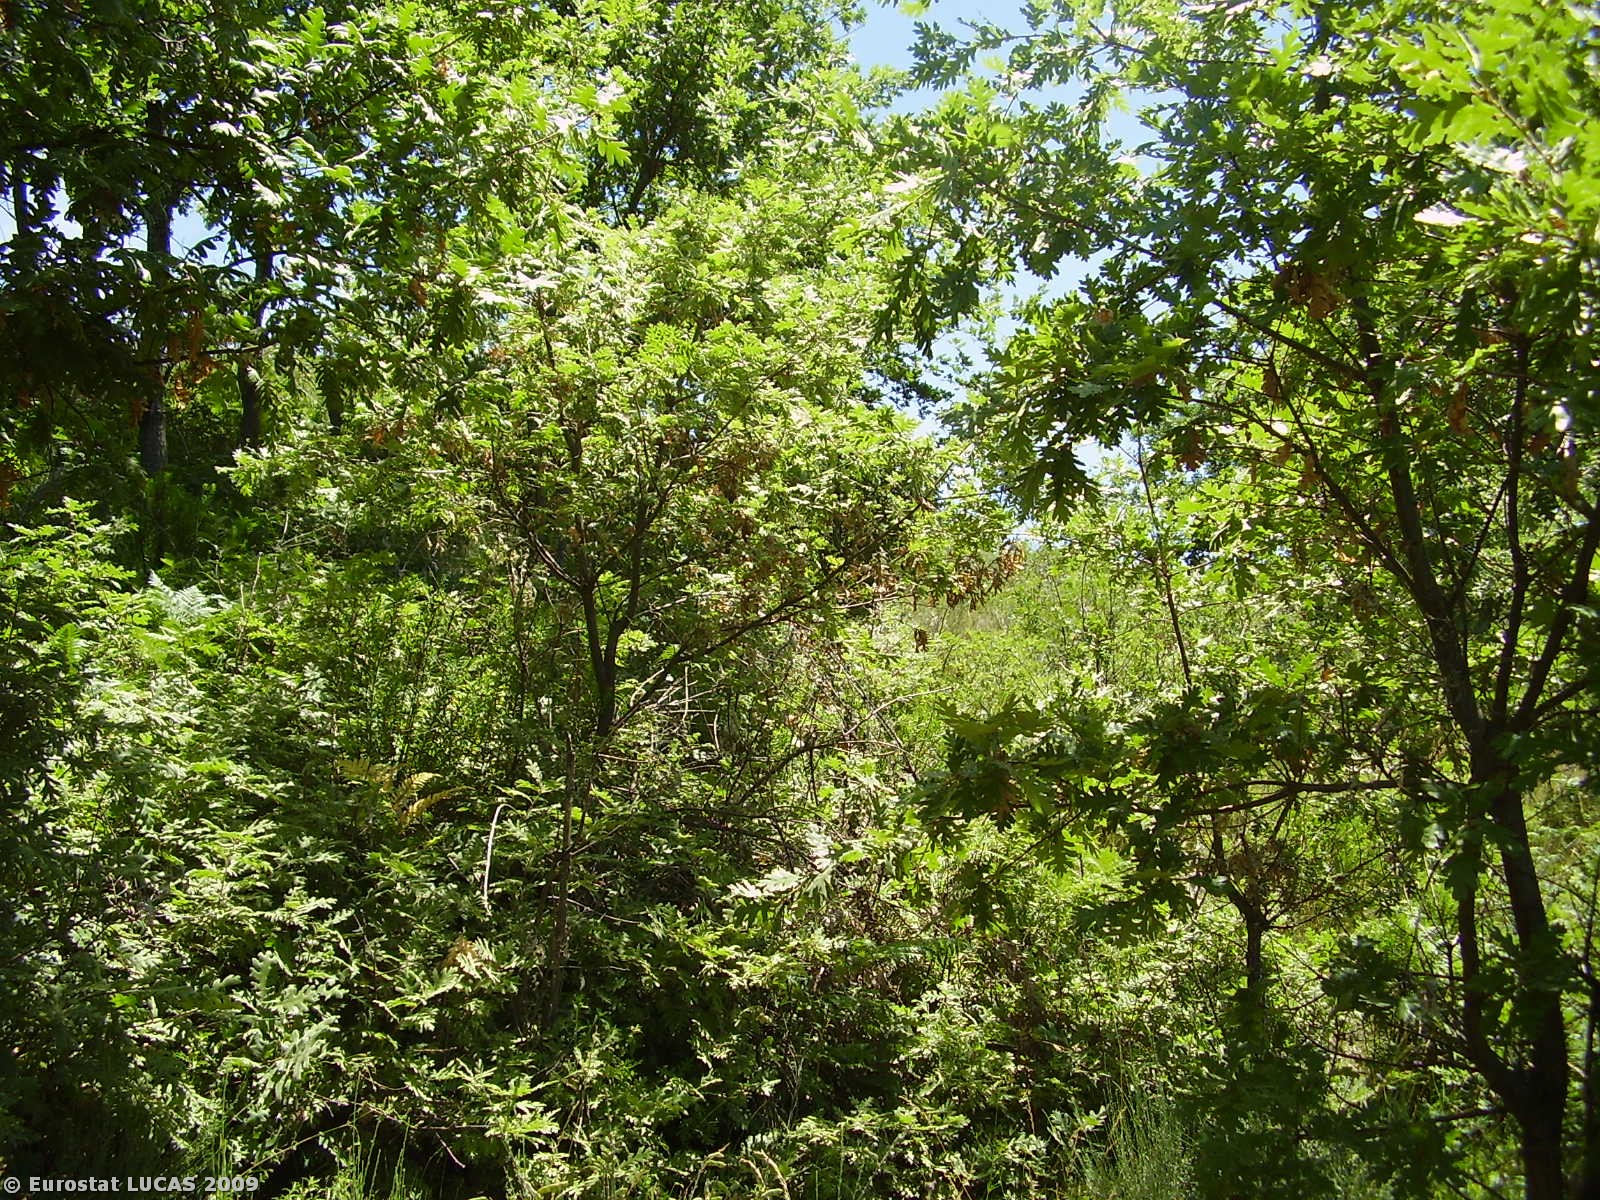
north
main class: Shrubland
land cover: Shrubland with sparse tree cover
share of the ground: 10 - 25 %
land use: Nature reserves
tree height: > 5 m
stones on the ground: 25 - 50 %
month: June
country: PT
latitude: 41.8622
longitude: -6.9234
